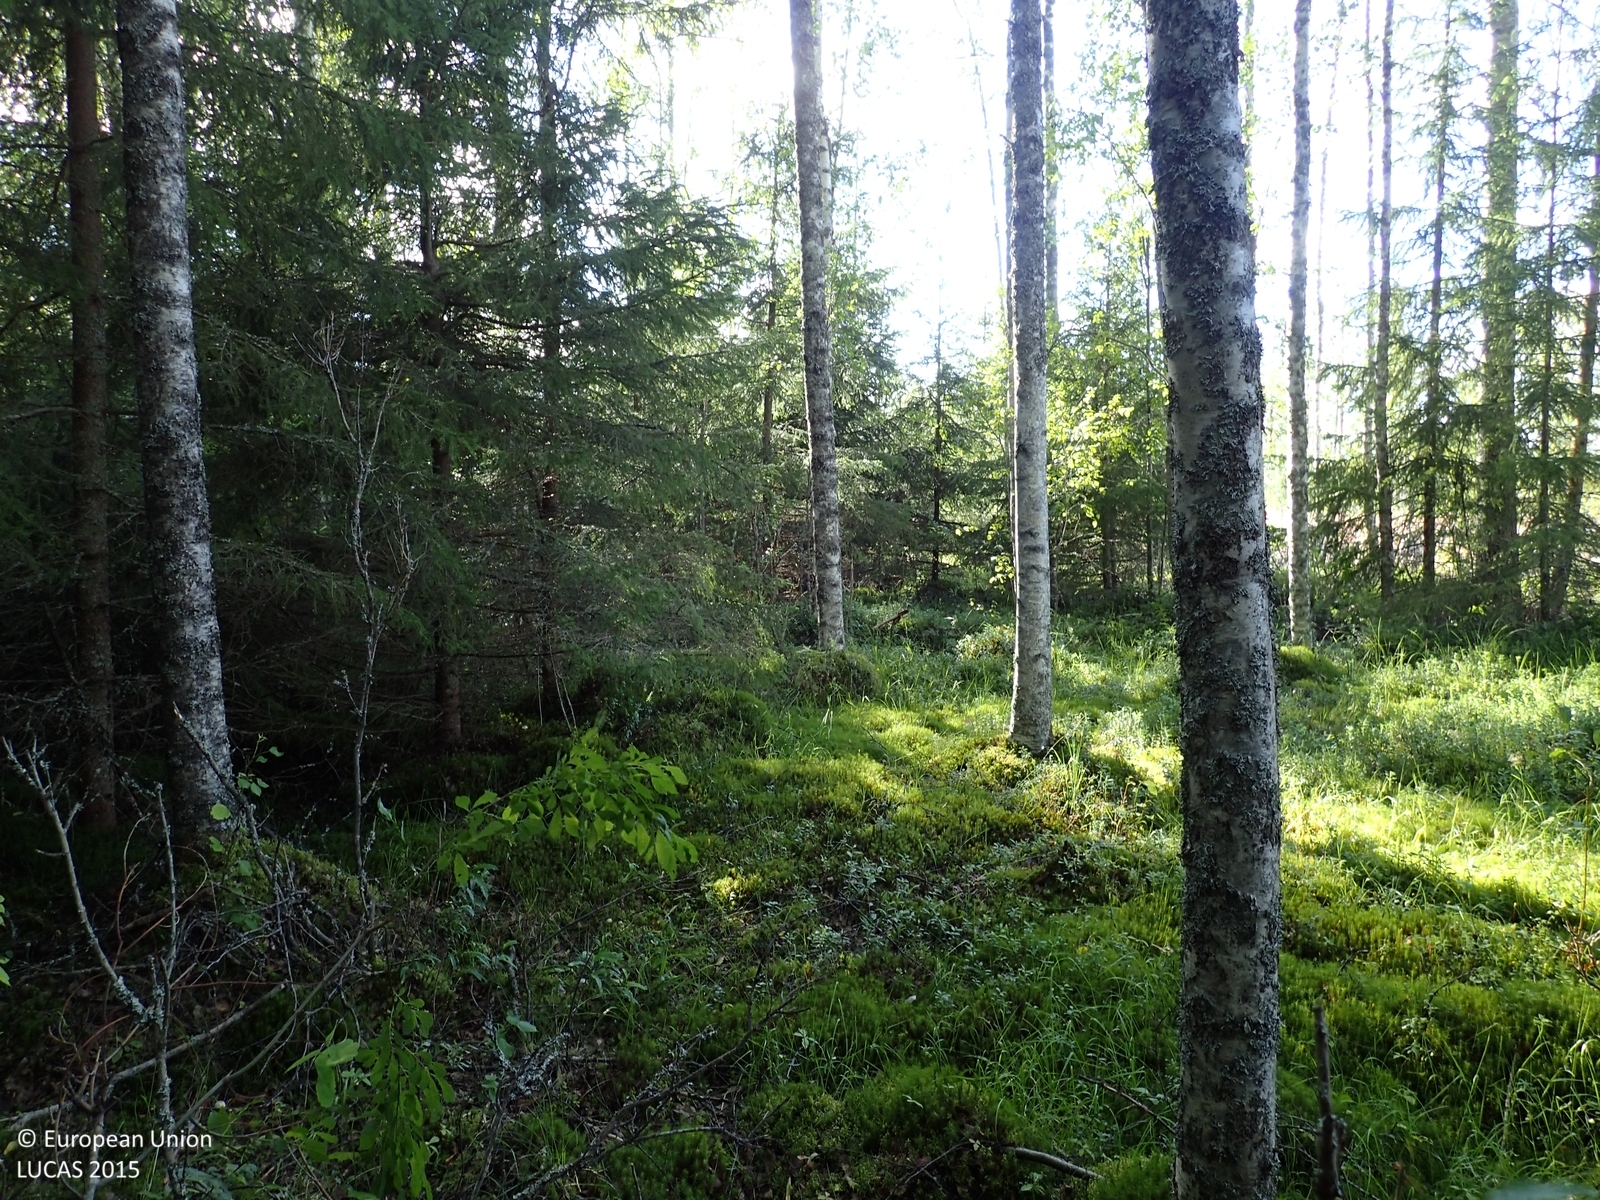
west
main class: Woodland
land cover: Spruce dominated mixed woodland
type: boreal forest
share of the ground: > 75 %
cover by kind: coniferous forest trees 50 %, broadleaved forest trees 30 %, shrubs 10 %, lichens and mosses 10 %
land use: Forestry
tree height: > 5 m
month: August
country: FI
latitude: 62.6450
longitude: 21.9666
